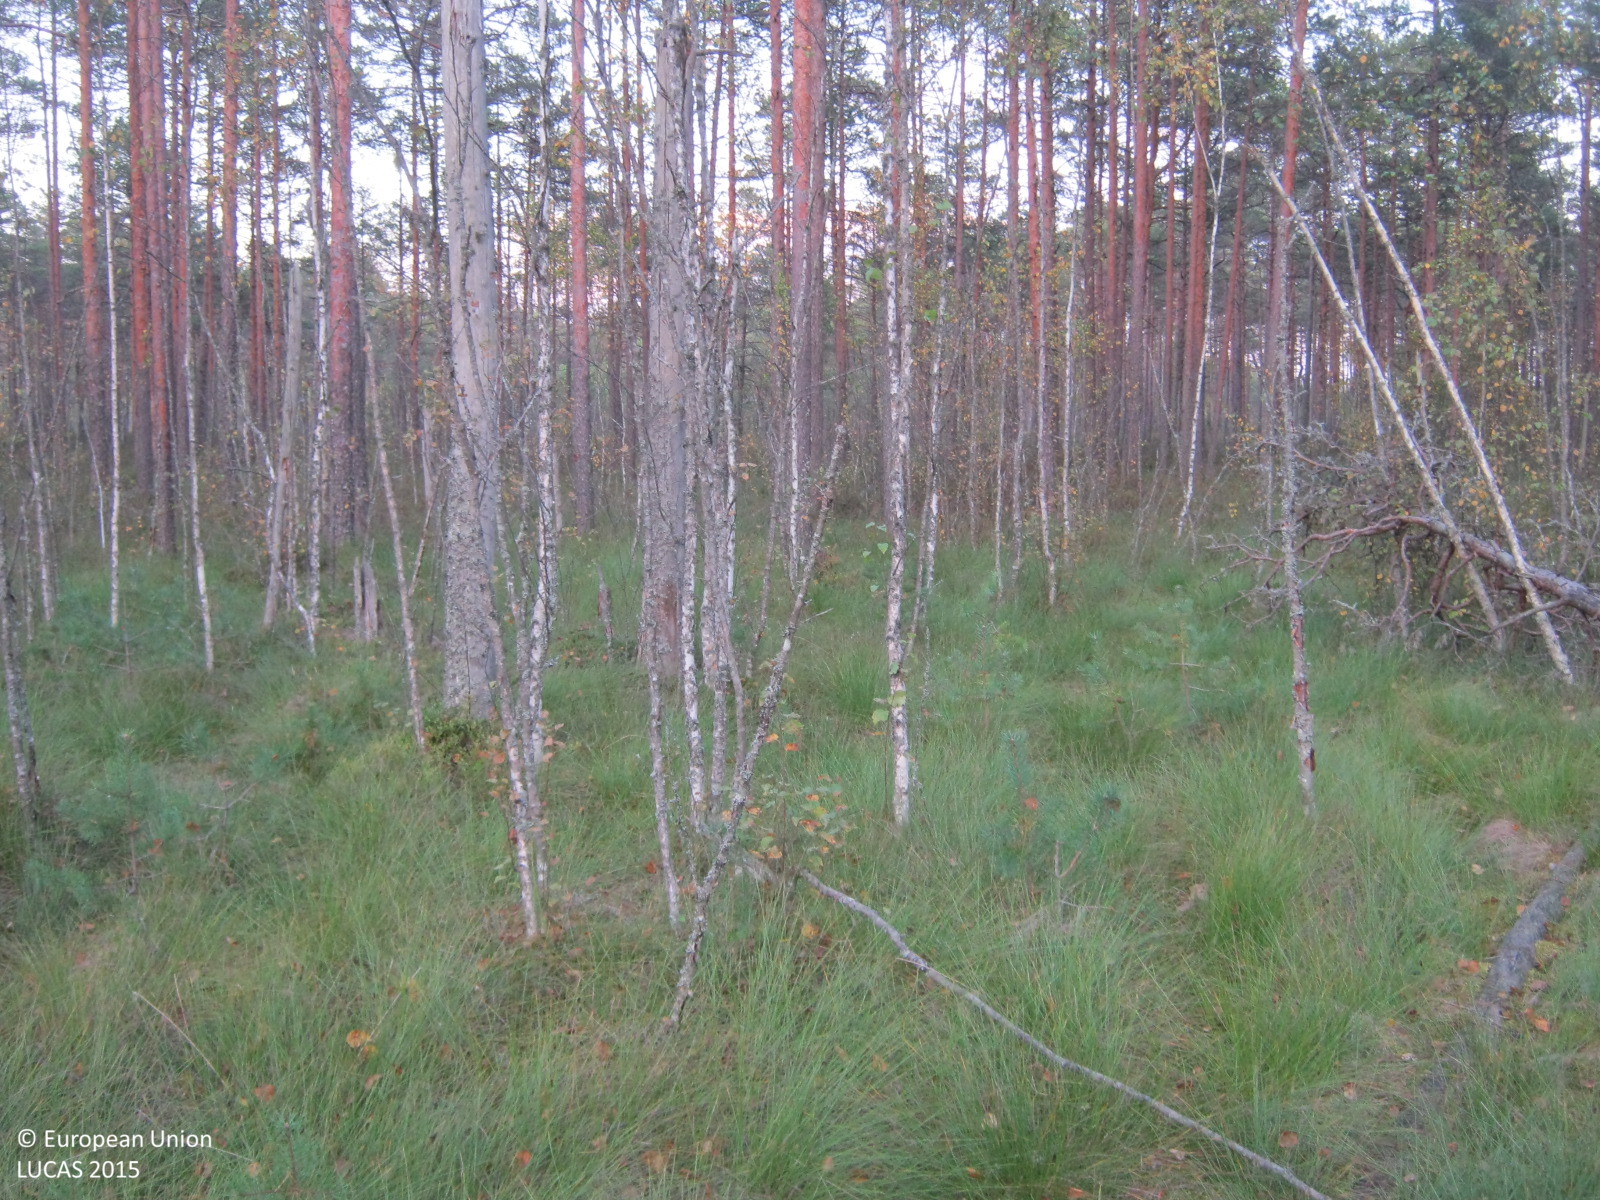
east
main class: Woodland
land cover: Pine dominated mixed woodland
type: hemiboreal forest and nemoral coniferous forest and mixed broadleaved-coniferous forest
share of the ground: > 75 %
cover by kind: coniferous forest trees 45 %, broadleaved forest trees 30 %, herbaceous plants 15 %, lichens and mosses 10 %
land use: Forestry
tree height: > 5 m
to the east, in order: Pine dominated mixed woodland; Pine dominated coniferous woodland
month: September
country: LV
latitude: 57.4157
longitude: 24.7652
